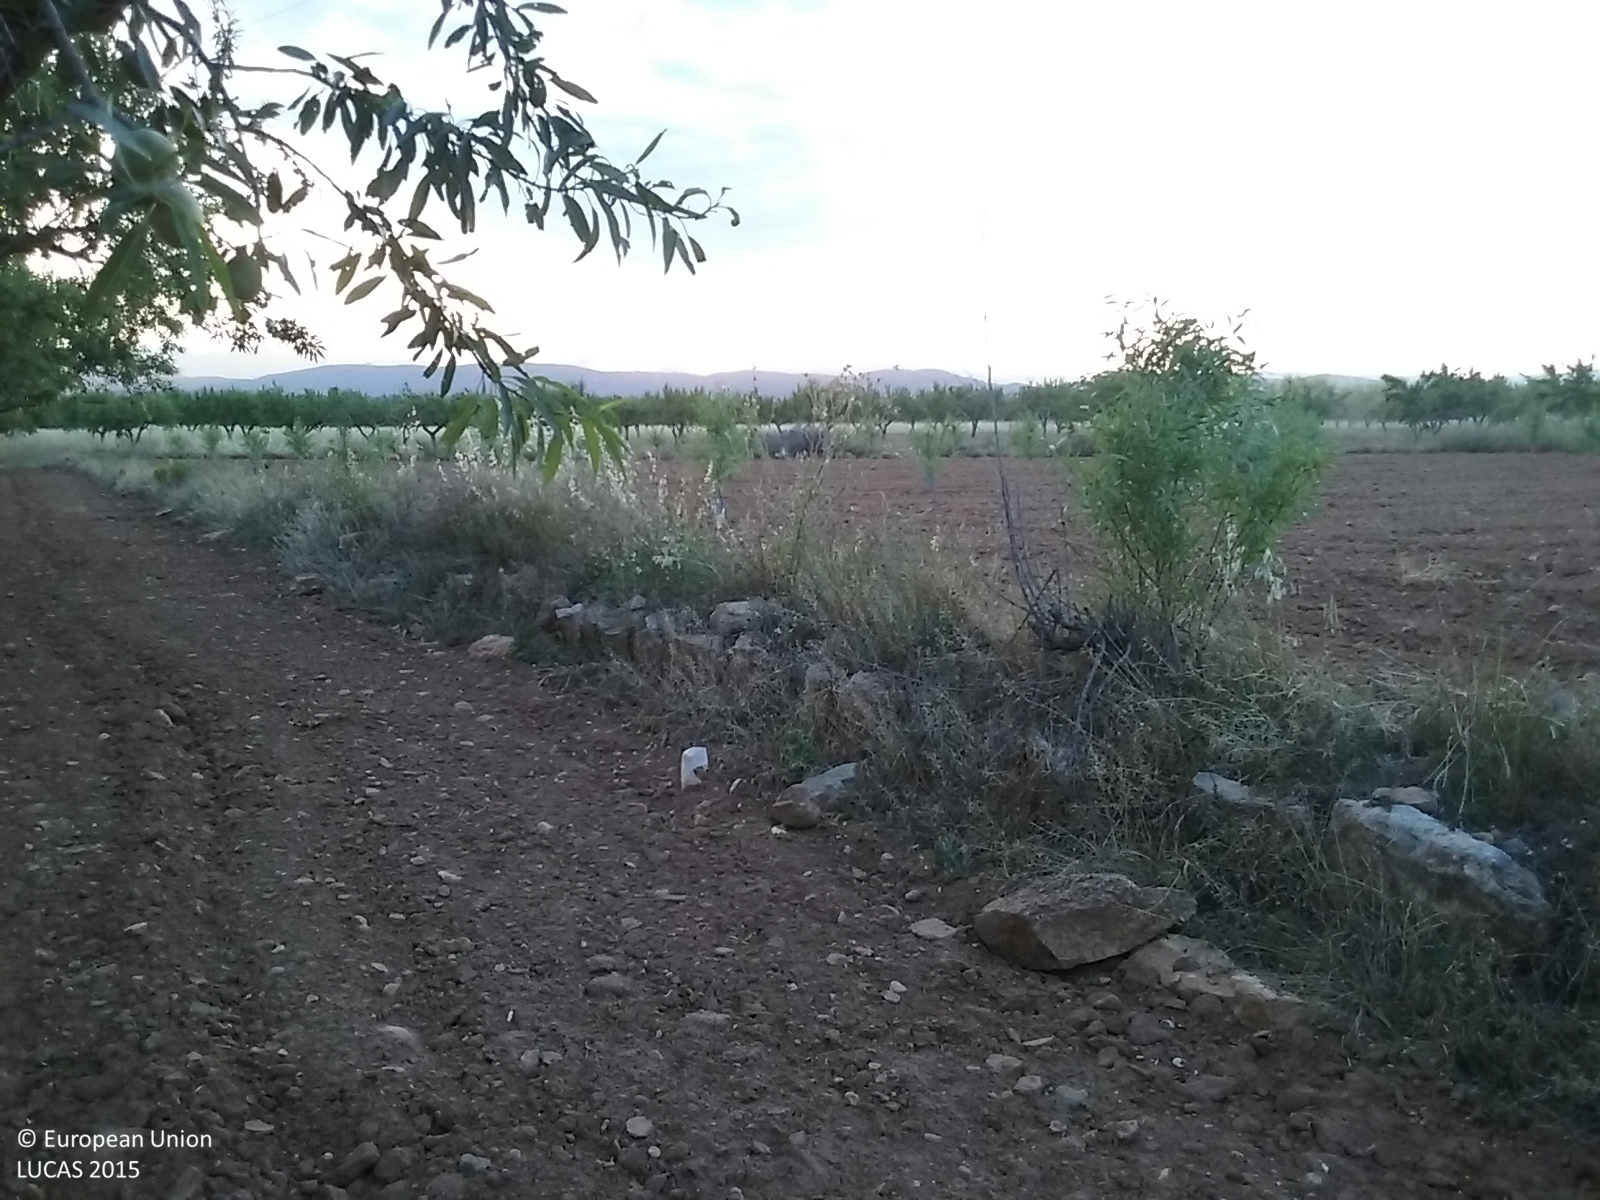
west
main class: Cropland
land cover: Nuts trees
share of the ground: 50 - 75 %
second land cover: Other bare soil
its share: > 75 %
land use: Agriculture (excluding fallow land and kitchen gardens)
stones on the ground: < 10 %
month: May
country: ES
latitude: 40.1853
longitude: -0.0686
